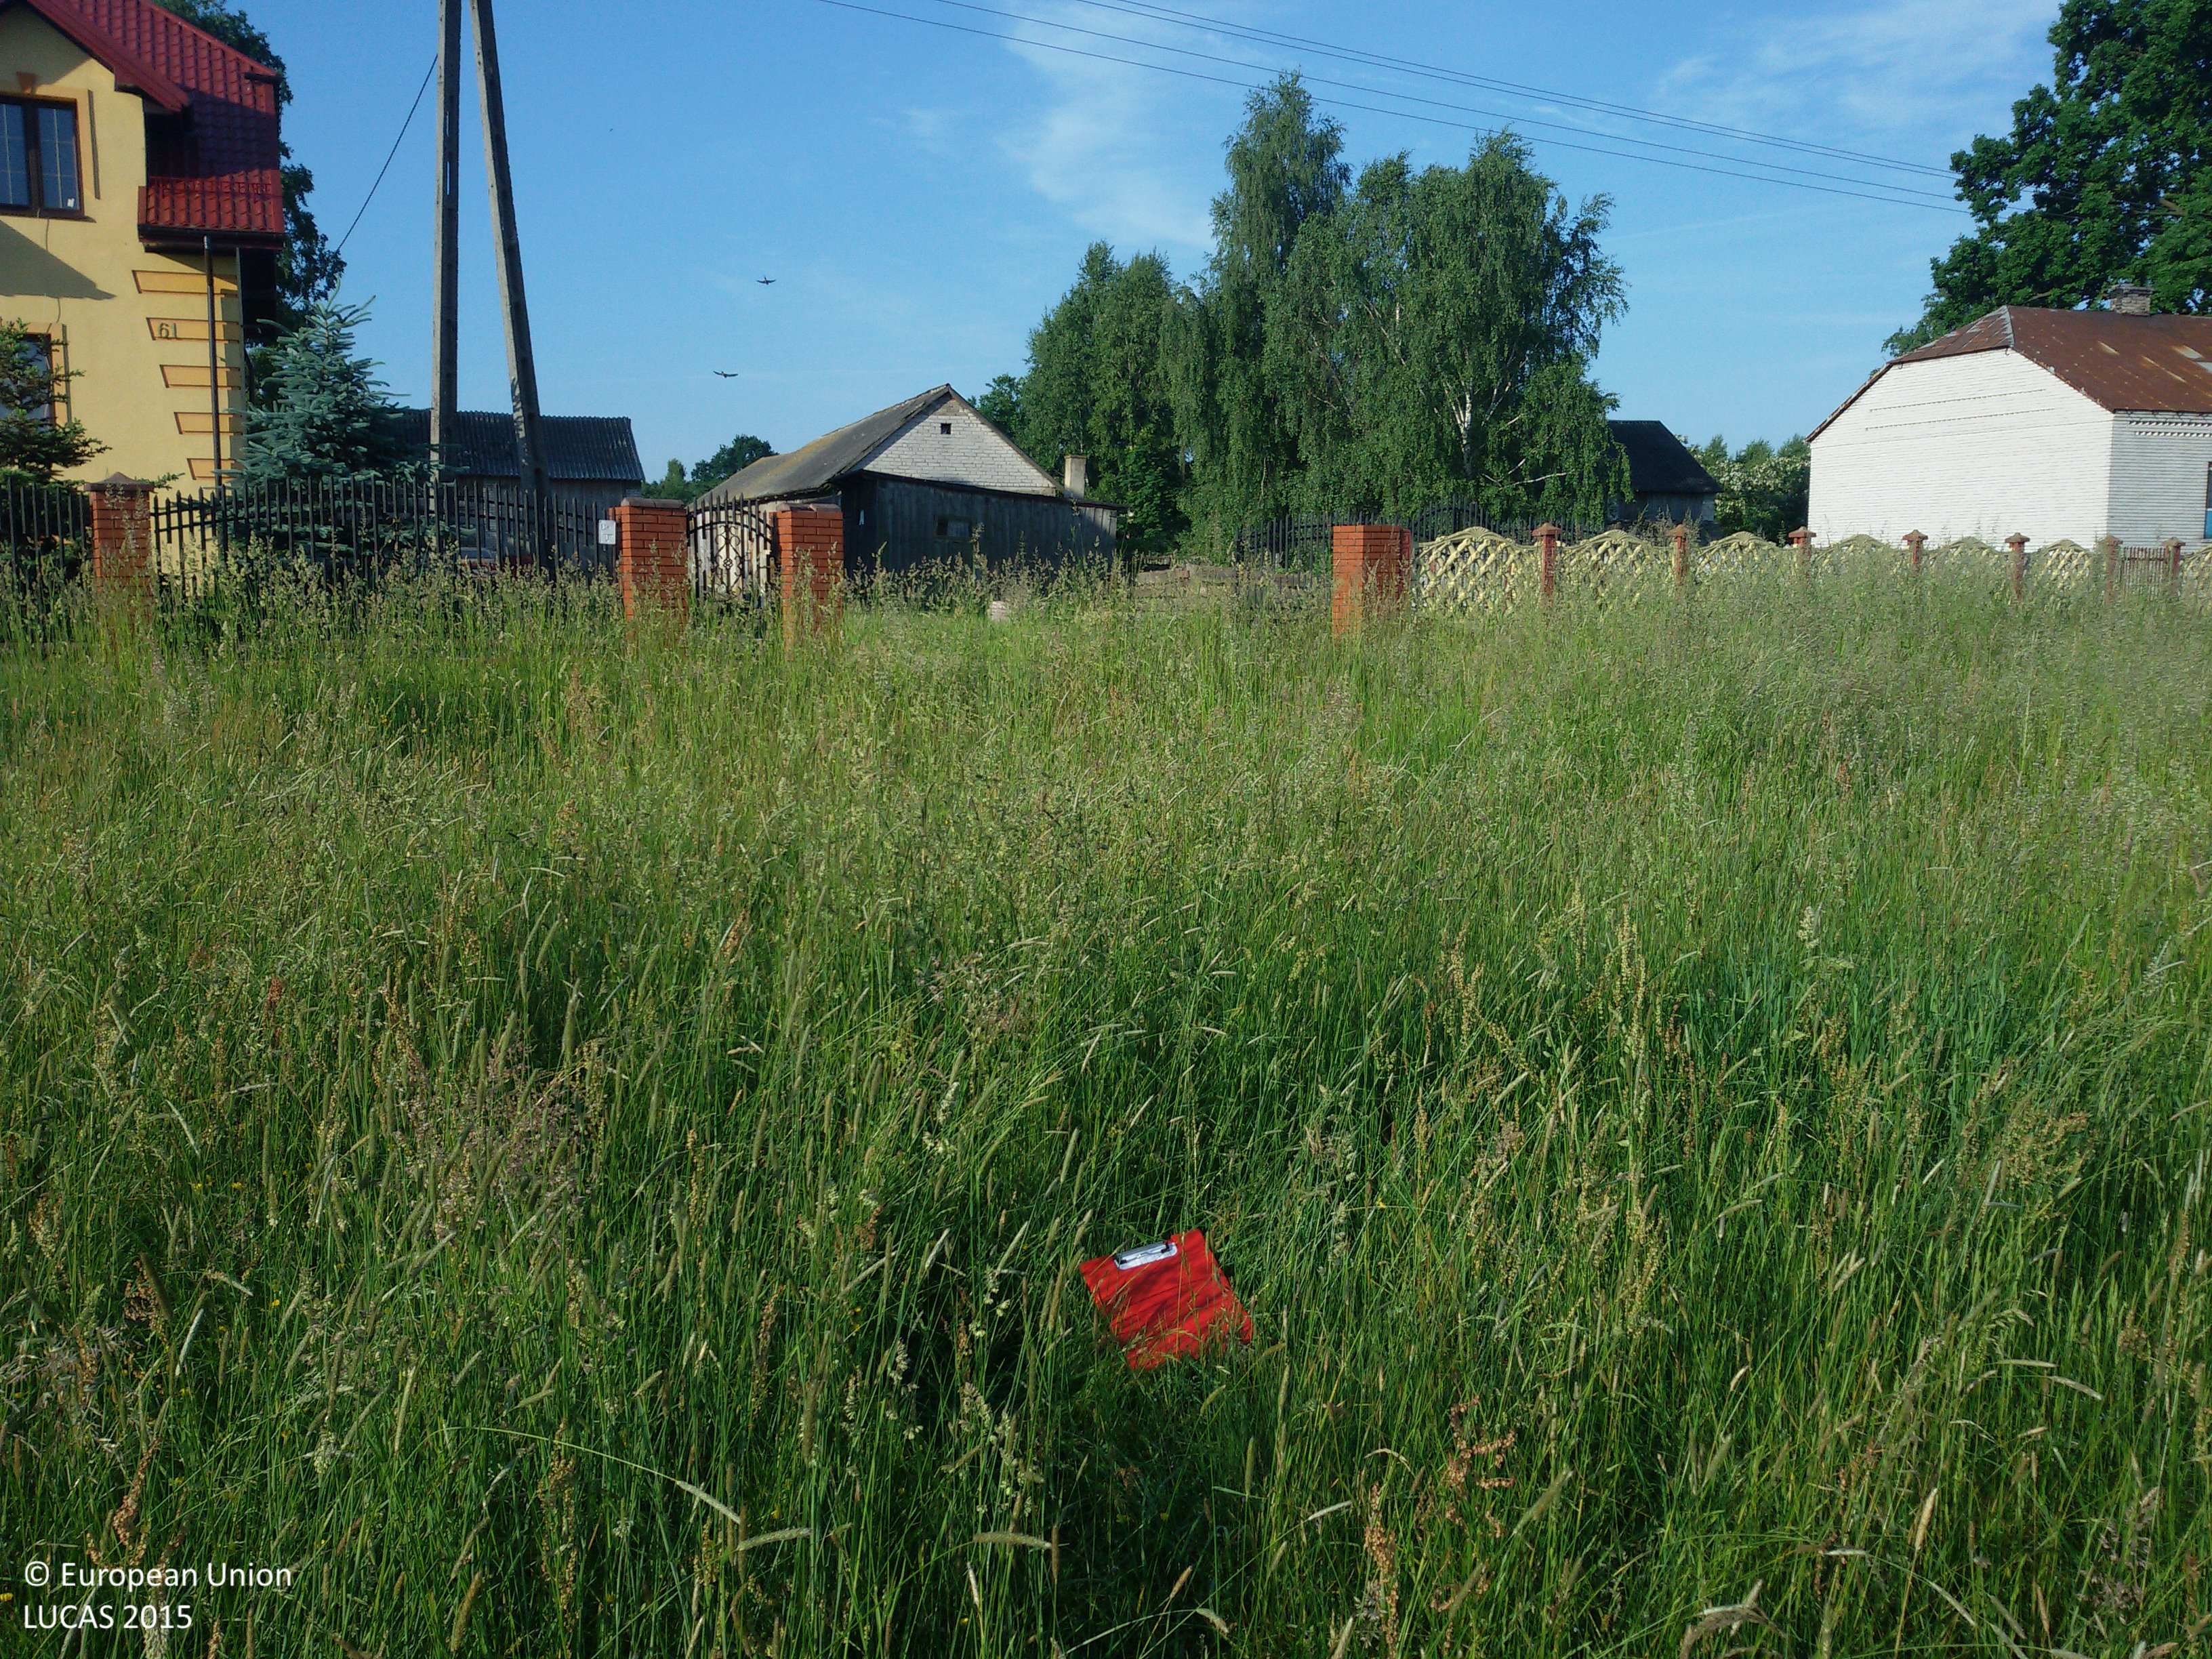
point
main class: Grassland
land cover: Grassland without tree/shrub cover
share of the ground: > 75 %
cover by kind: herbaceous plants 100 %
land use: Agriculture (excluding fallow land and kitchen gardens)
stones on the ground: < 10 %
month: June
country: PL
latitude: 51.4847
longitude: 20.5952
